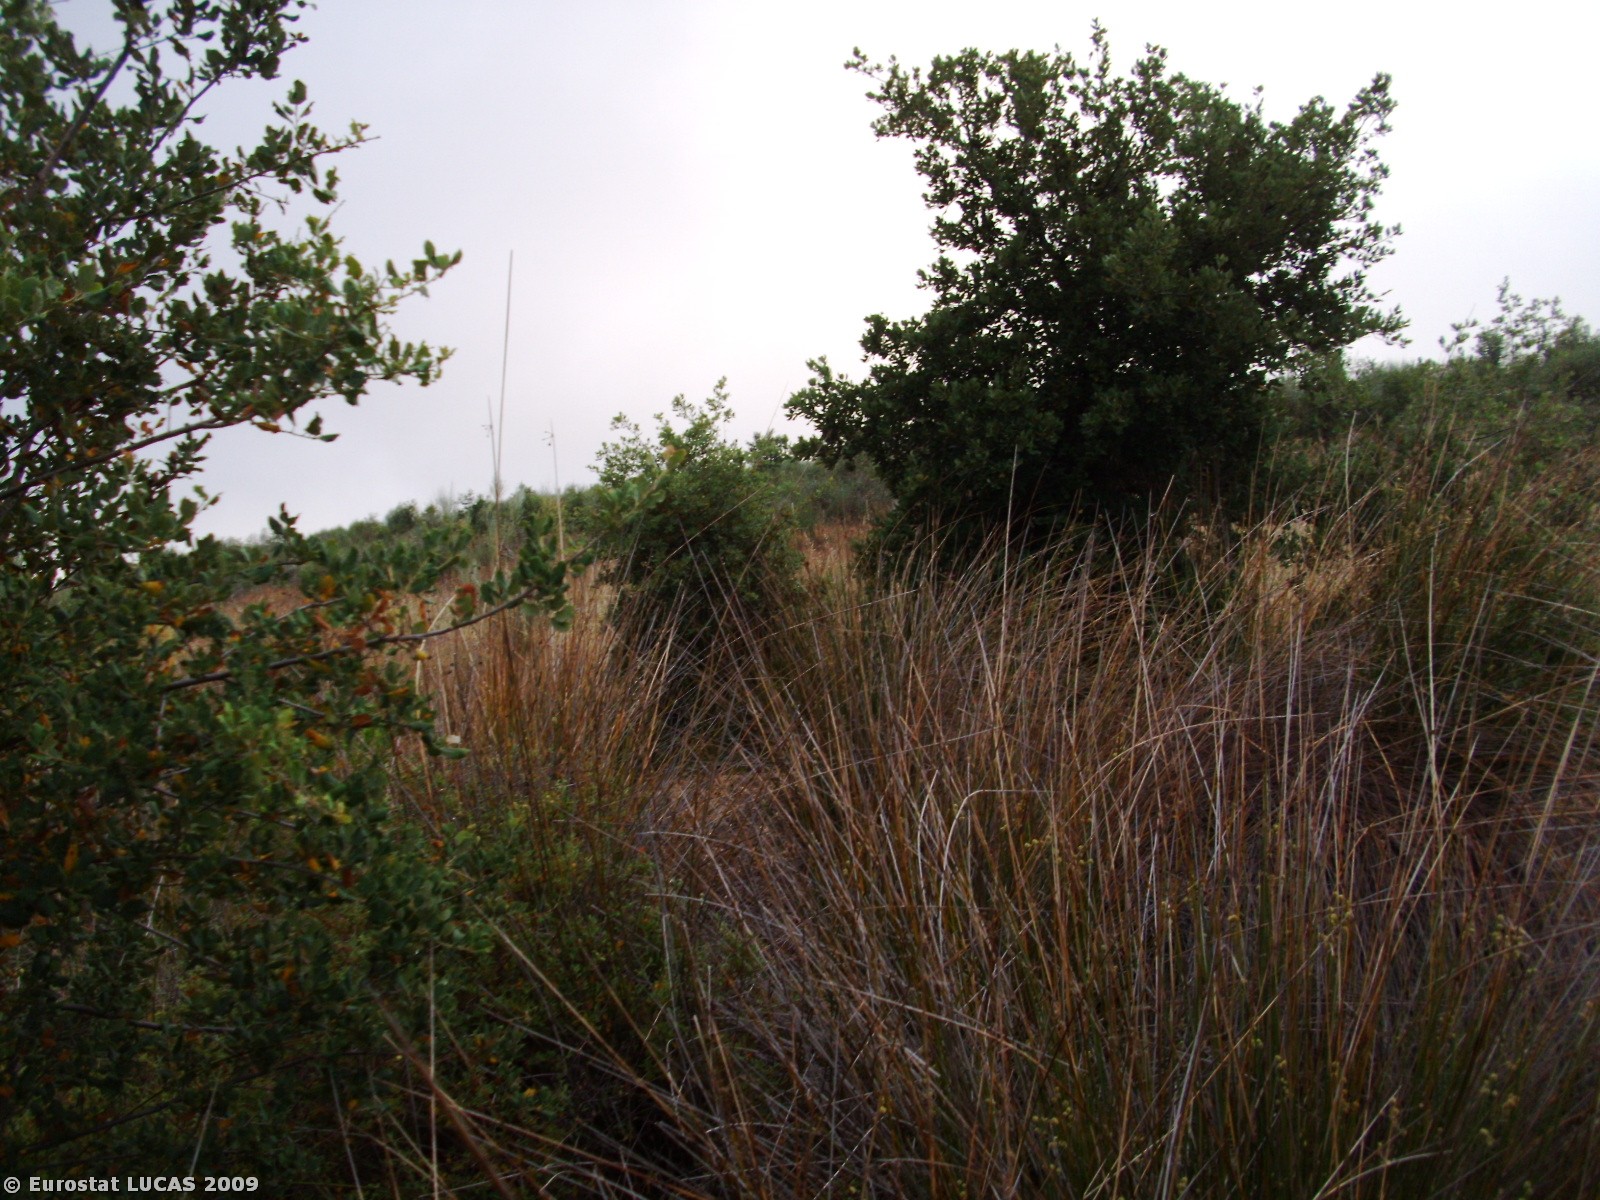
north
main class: Woodland
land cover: Broadleaved woodland
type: broadleaved evergreen forest
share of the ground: 25 - 50 %
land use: Forestry
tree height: > 5 m
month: June
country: PT
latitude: 39.7017
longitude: -7.3663
